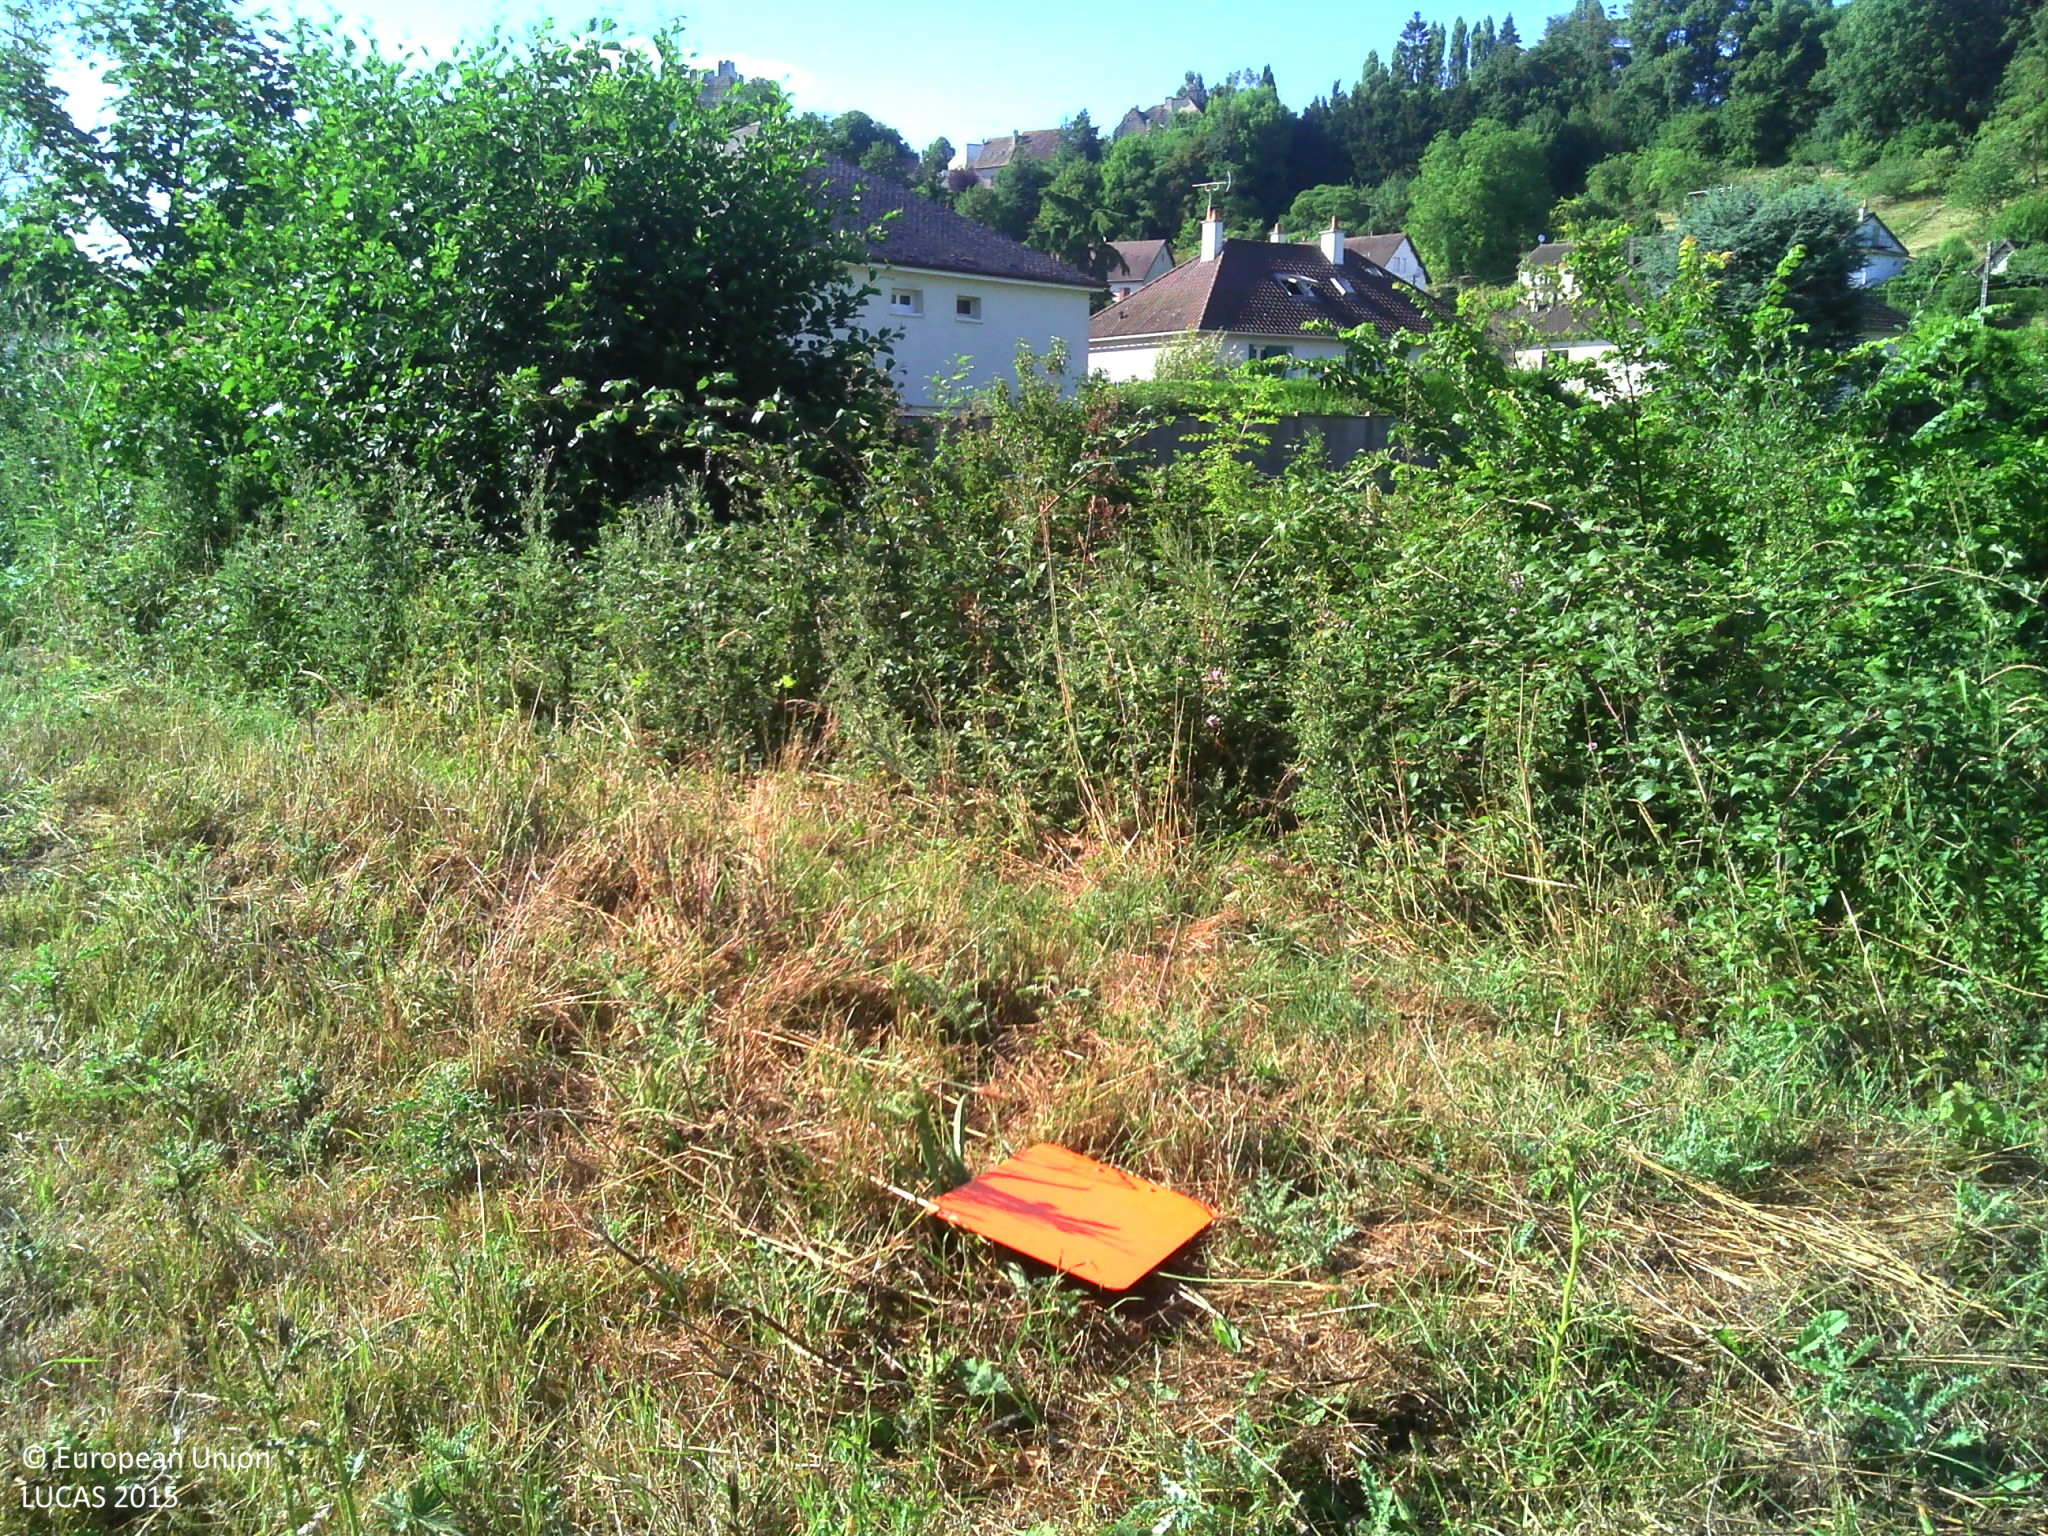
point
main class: Grassland
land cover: Grassland without tree/shrub cover
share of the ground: > 75 %
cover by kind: herbaceous plants 100 %
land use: Agriculture (excluding fallow land and kitchen gardens)
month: July
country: FR
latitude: 48.3109
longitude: 0.8231
